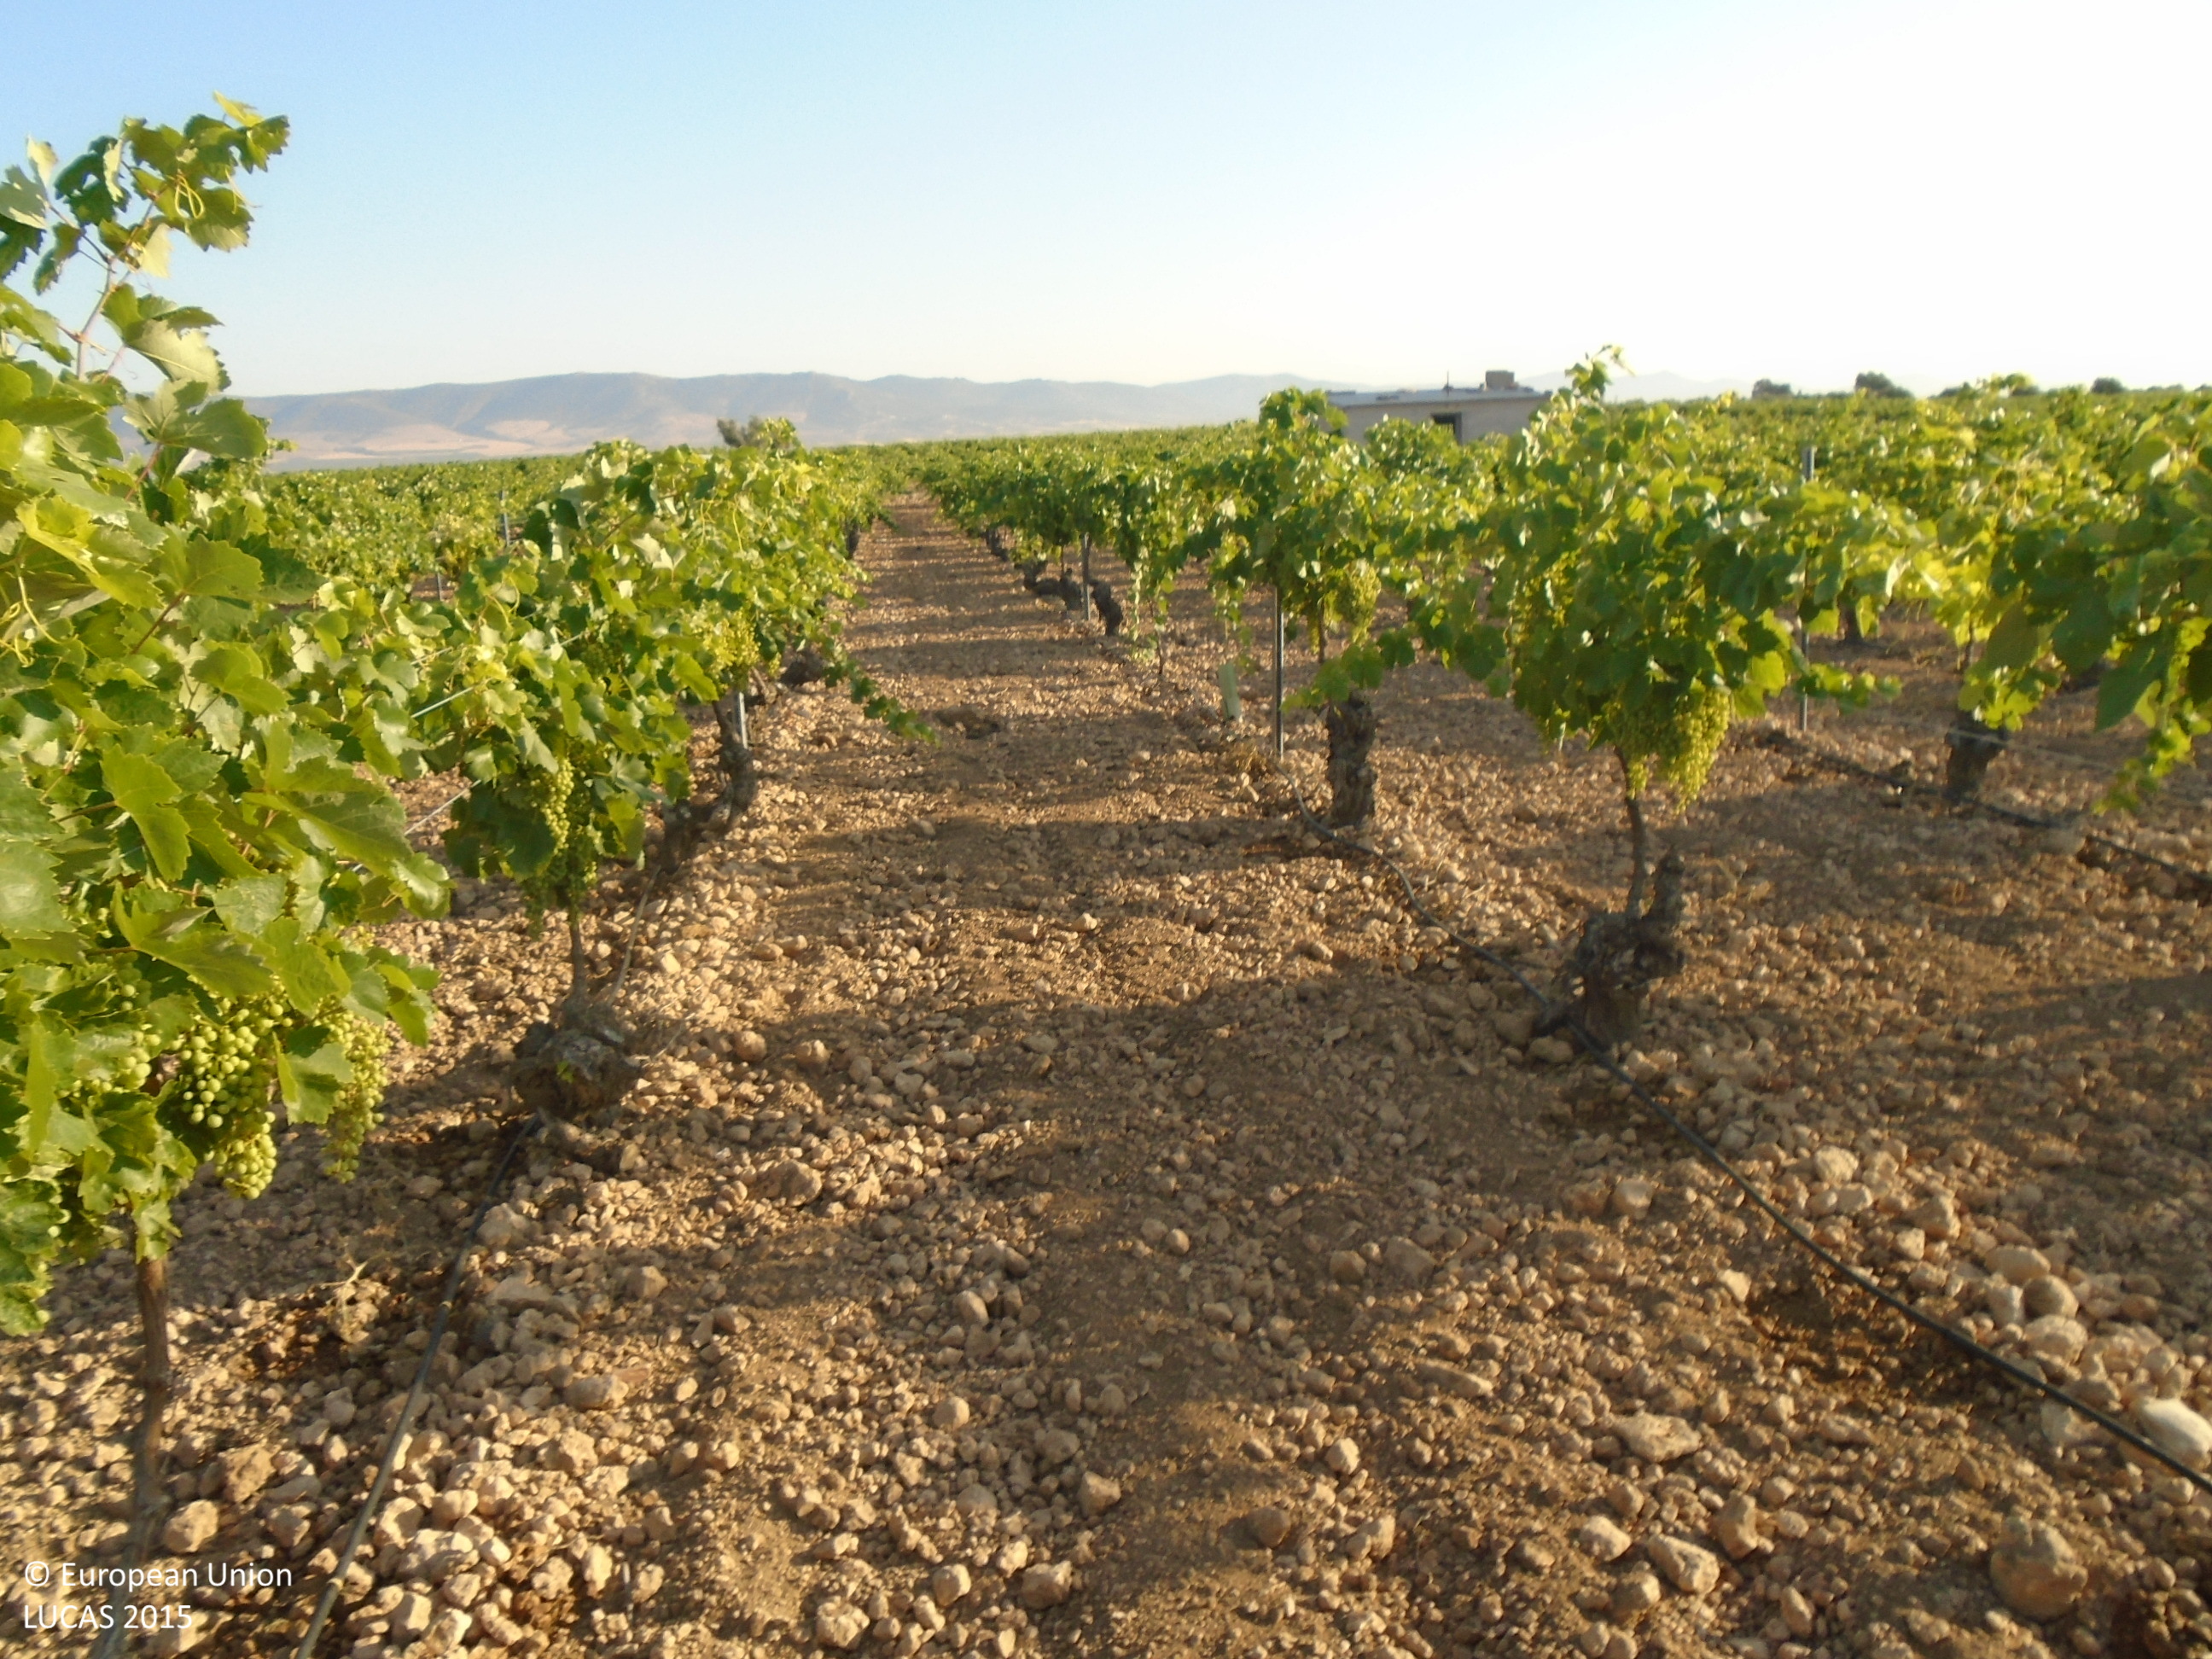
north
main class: Cropland
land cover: Vineyards
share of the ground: 10 - 25 %
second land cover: Other bare soil
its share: > 75 %
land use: Agriculture (excluding fallow land and kitchen gardens)
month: June
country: ES
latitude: 39.1484
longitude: -3.6149
